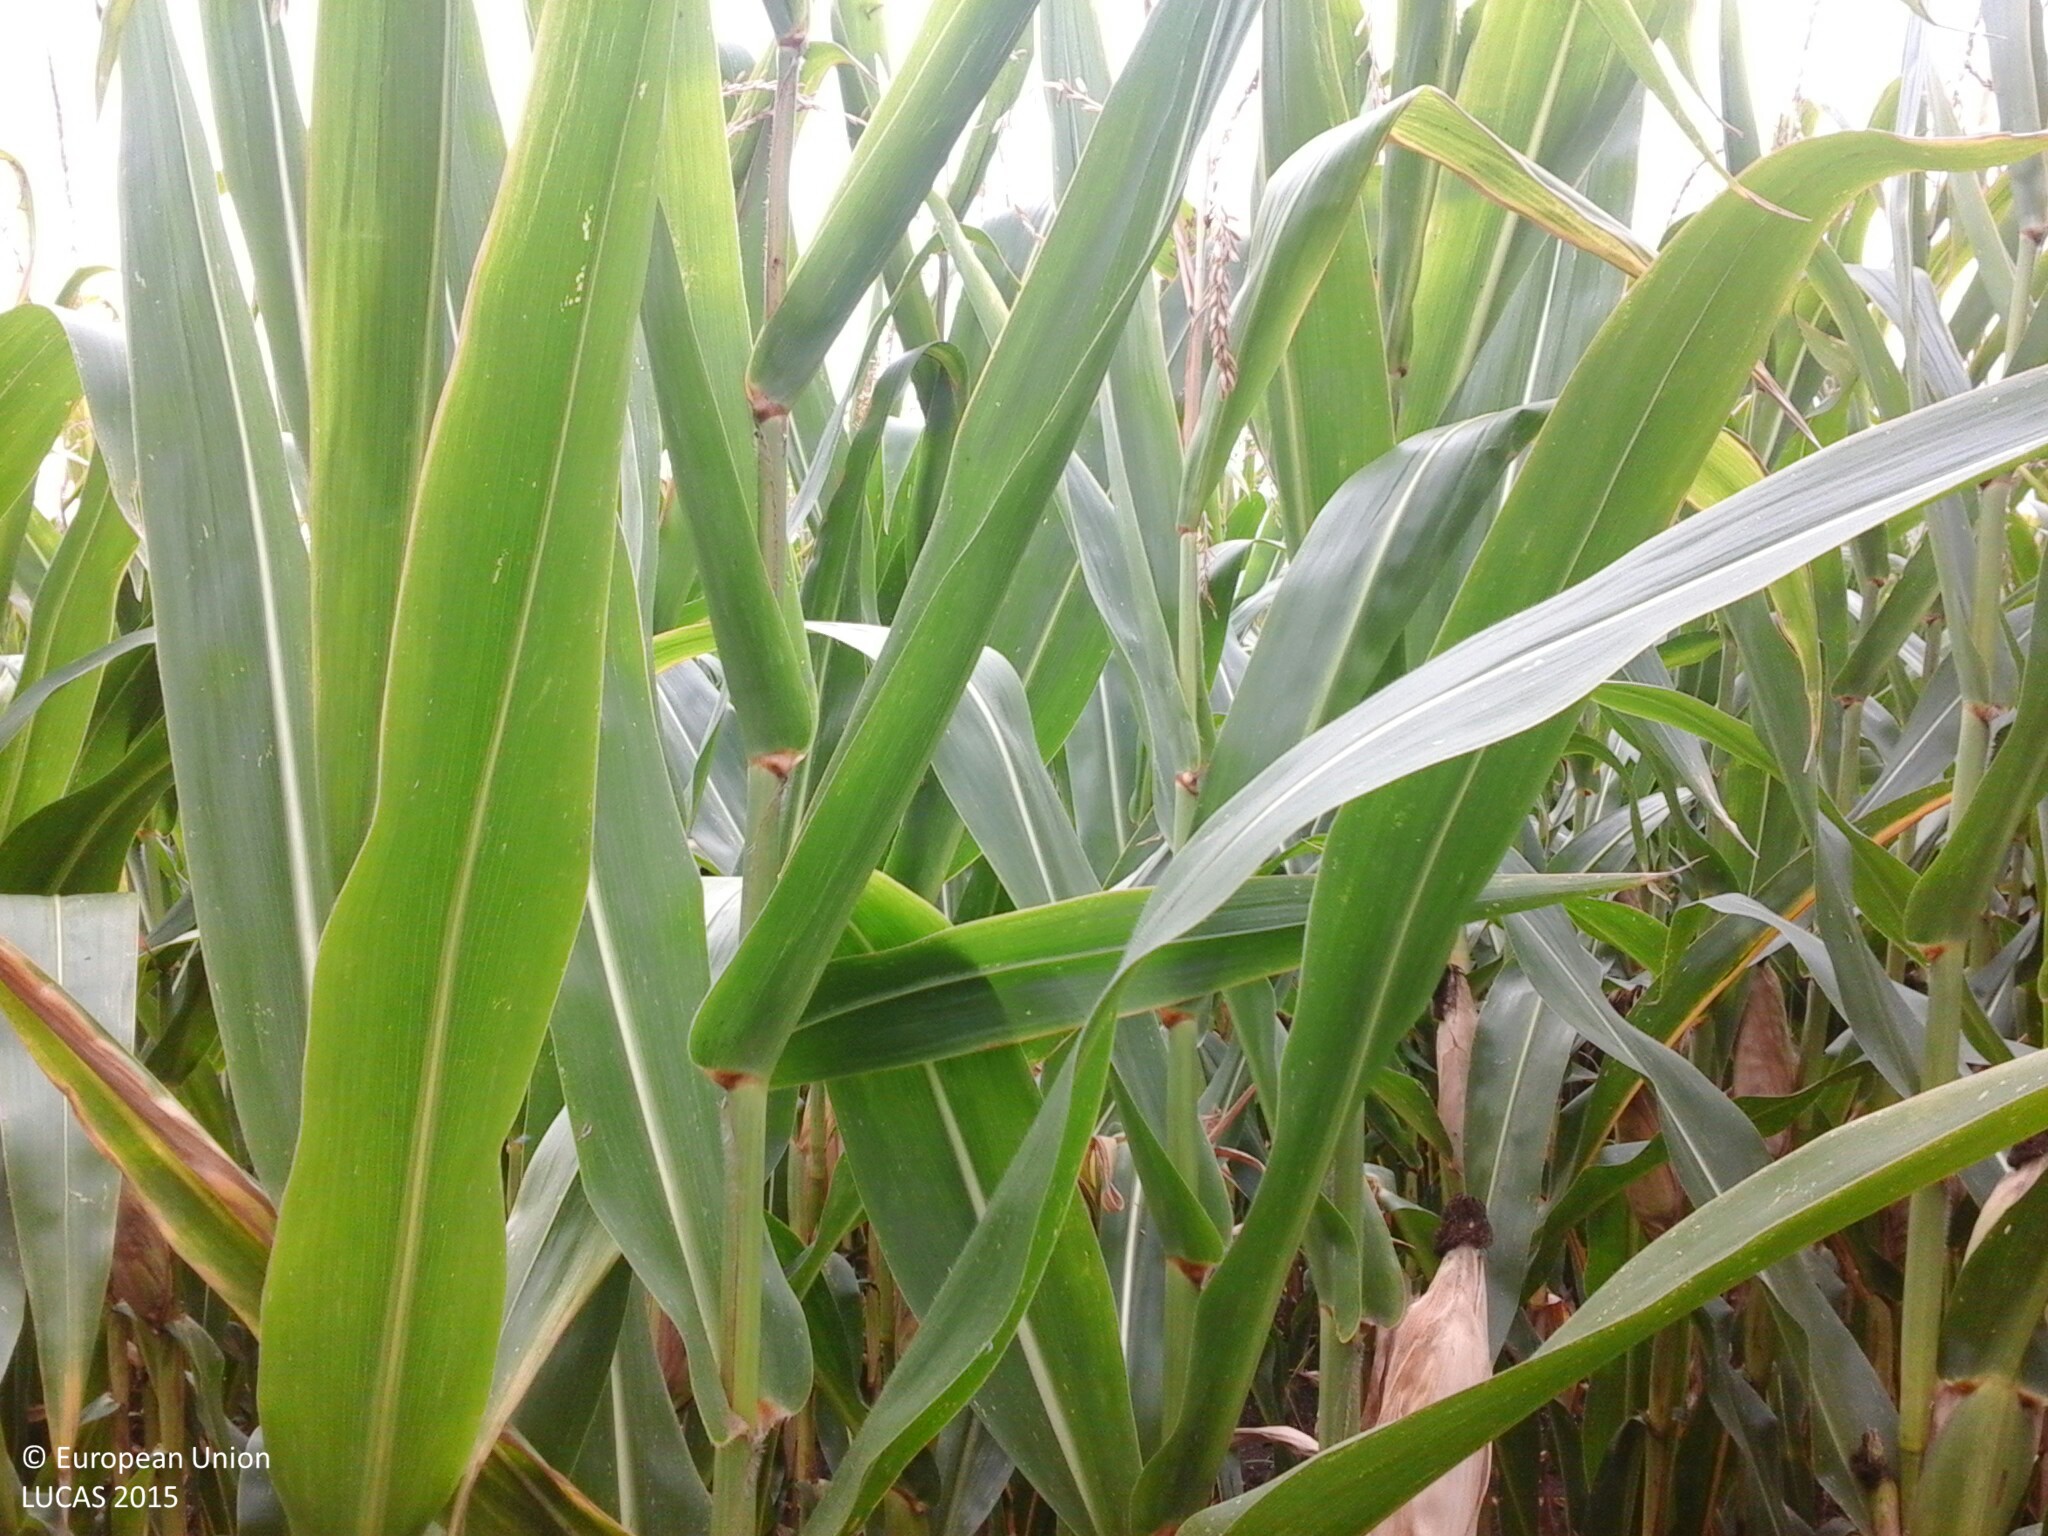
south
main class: Cropland
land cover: Maize
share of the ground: > 75 %
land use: Agriculture (excluding fallow land and kitchen gardens)
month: August
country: HU
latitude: 47.0263
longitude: 21.6074
